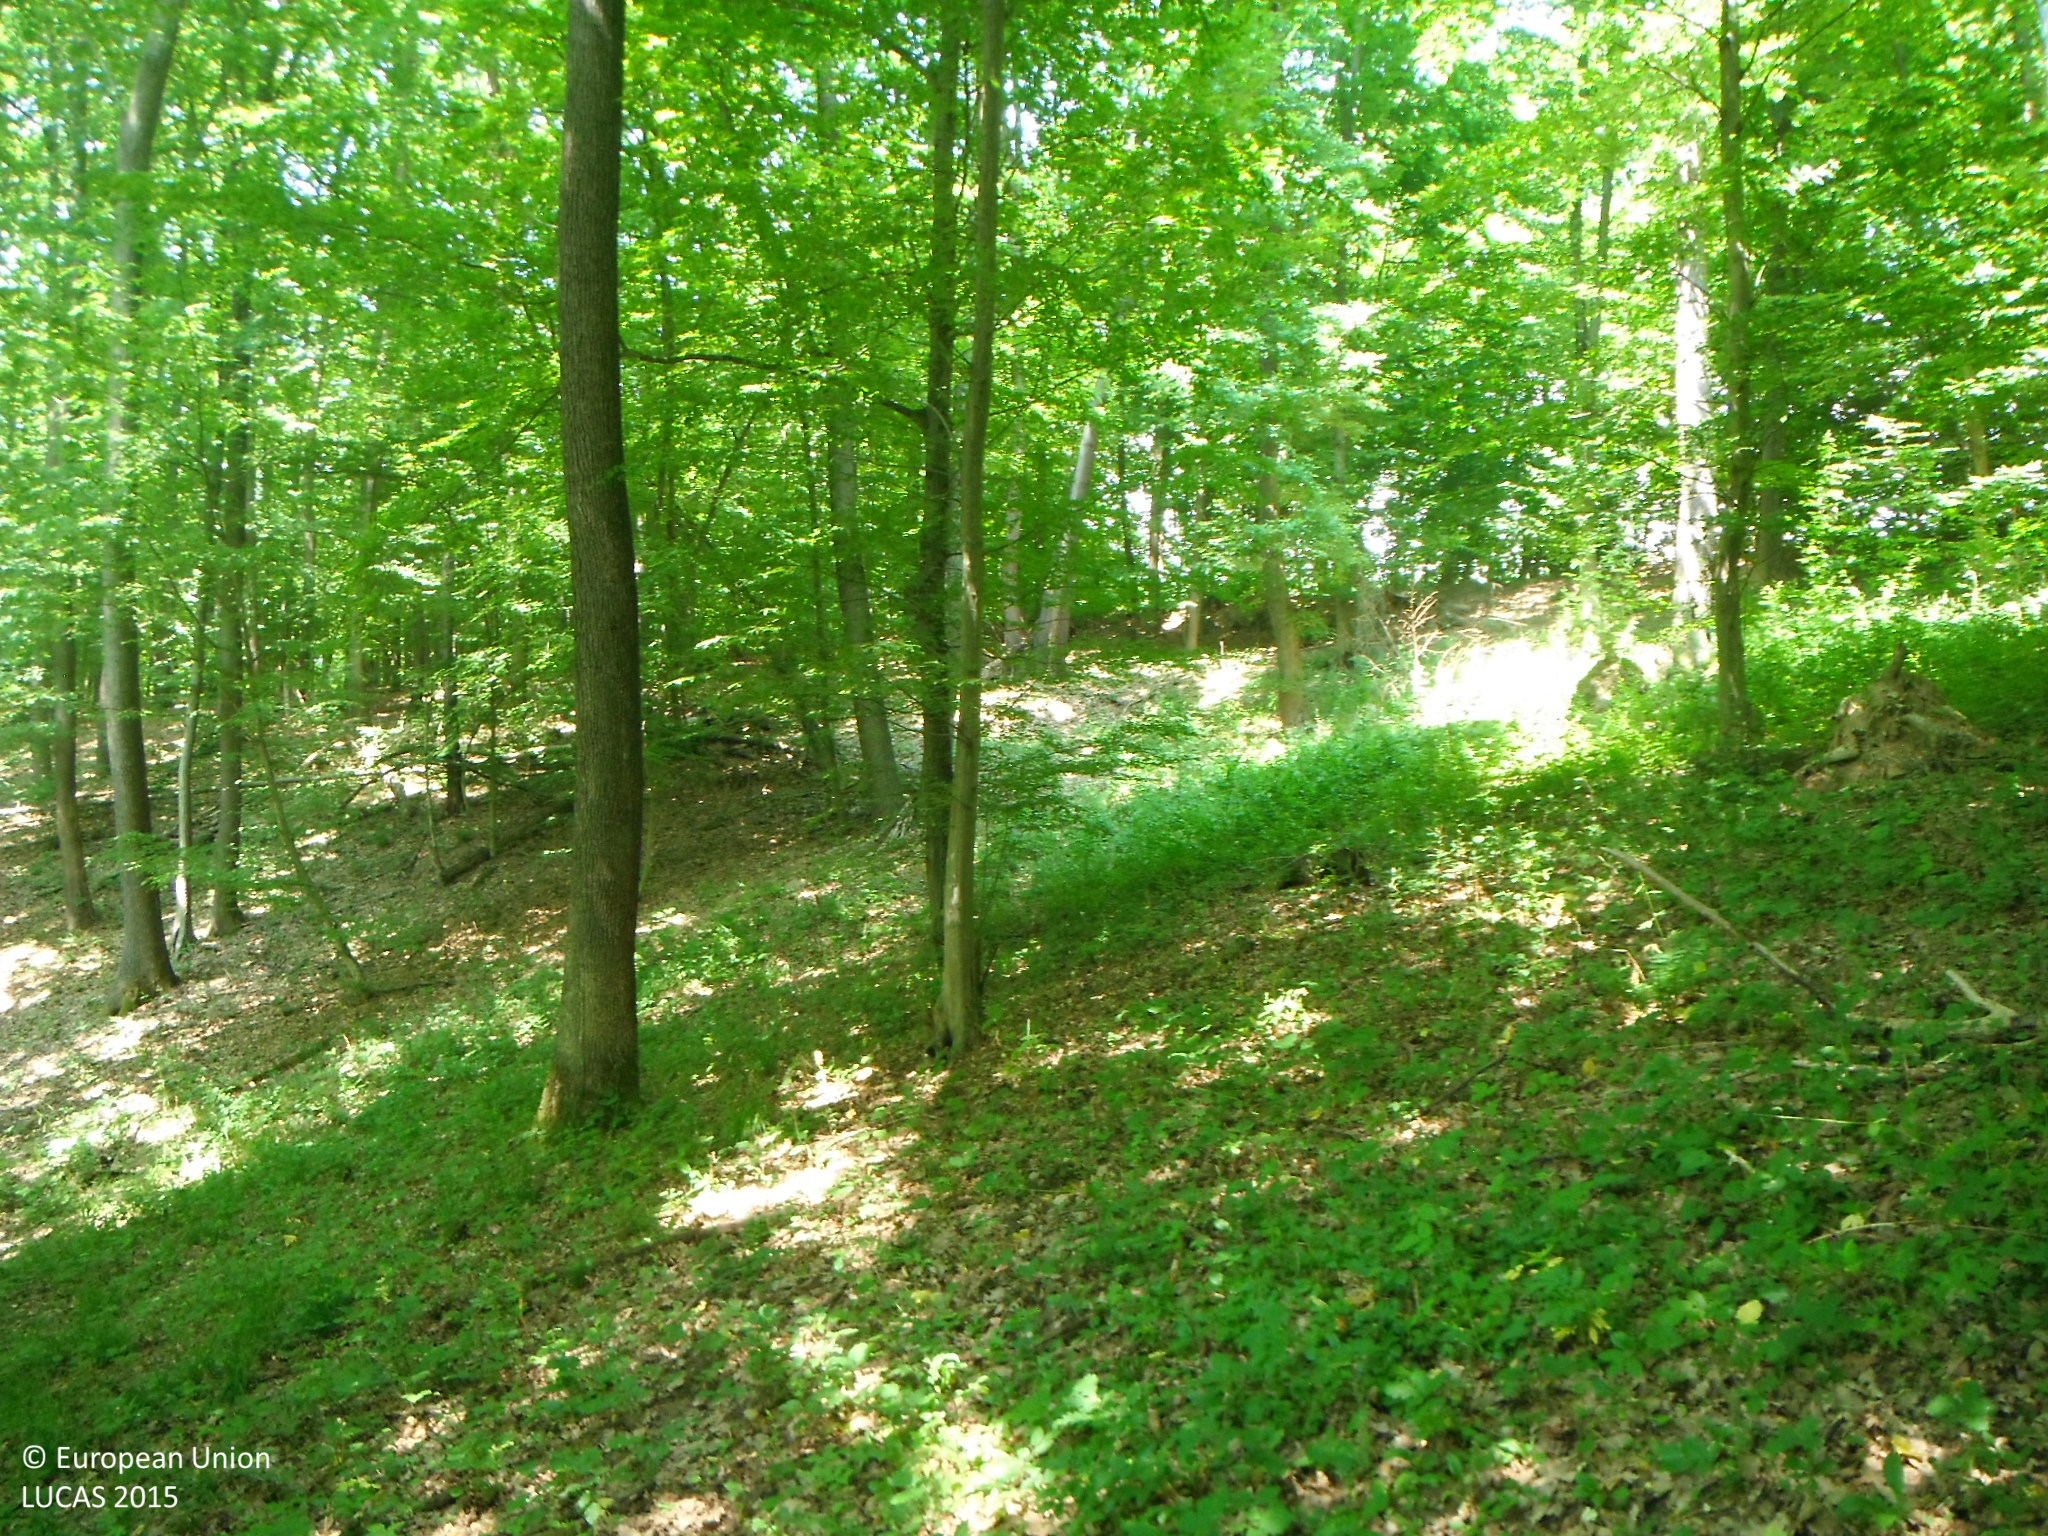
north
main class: Woodland
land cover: Broadleaved woodland
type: mesophytic deciduous forest
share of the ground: > 75 %
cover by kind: broadleaved forest trees 100 %
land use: Forestry
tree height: > 5 m
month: June
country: SK
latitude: 48.6720
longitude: 19.1889
